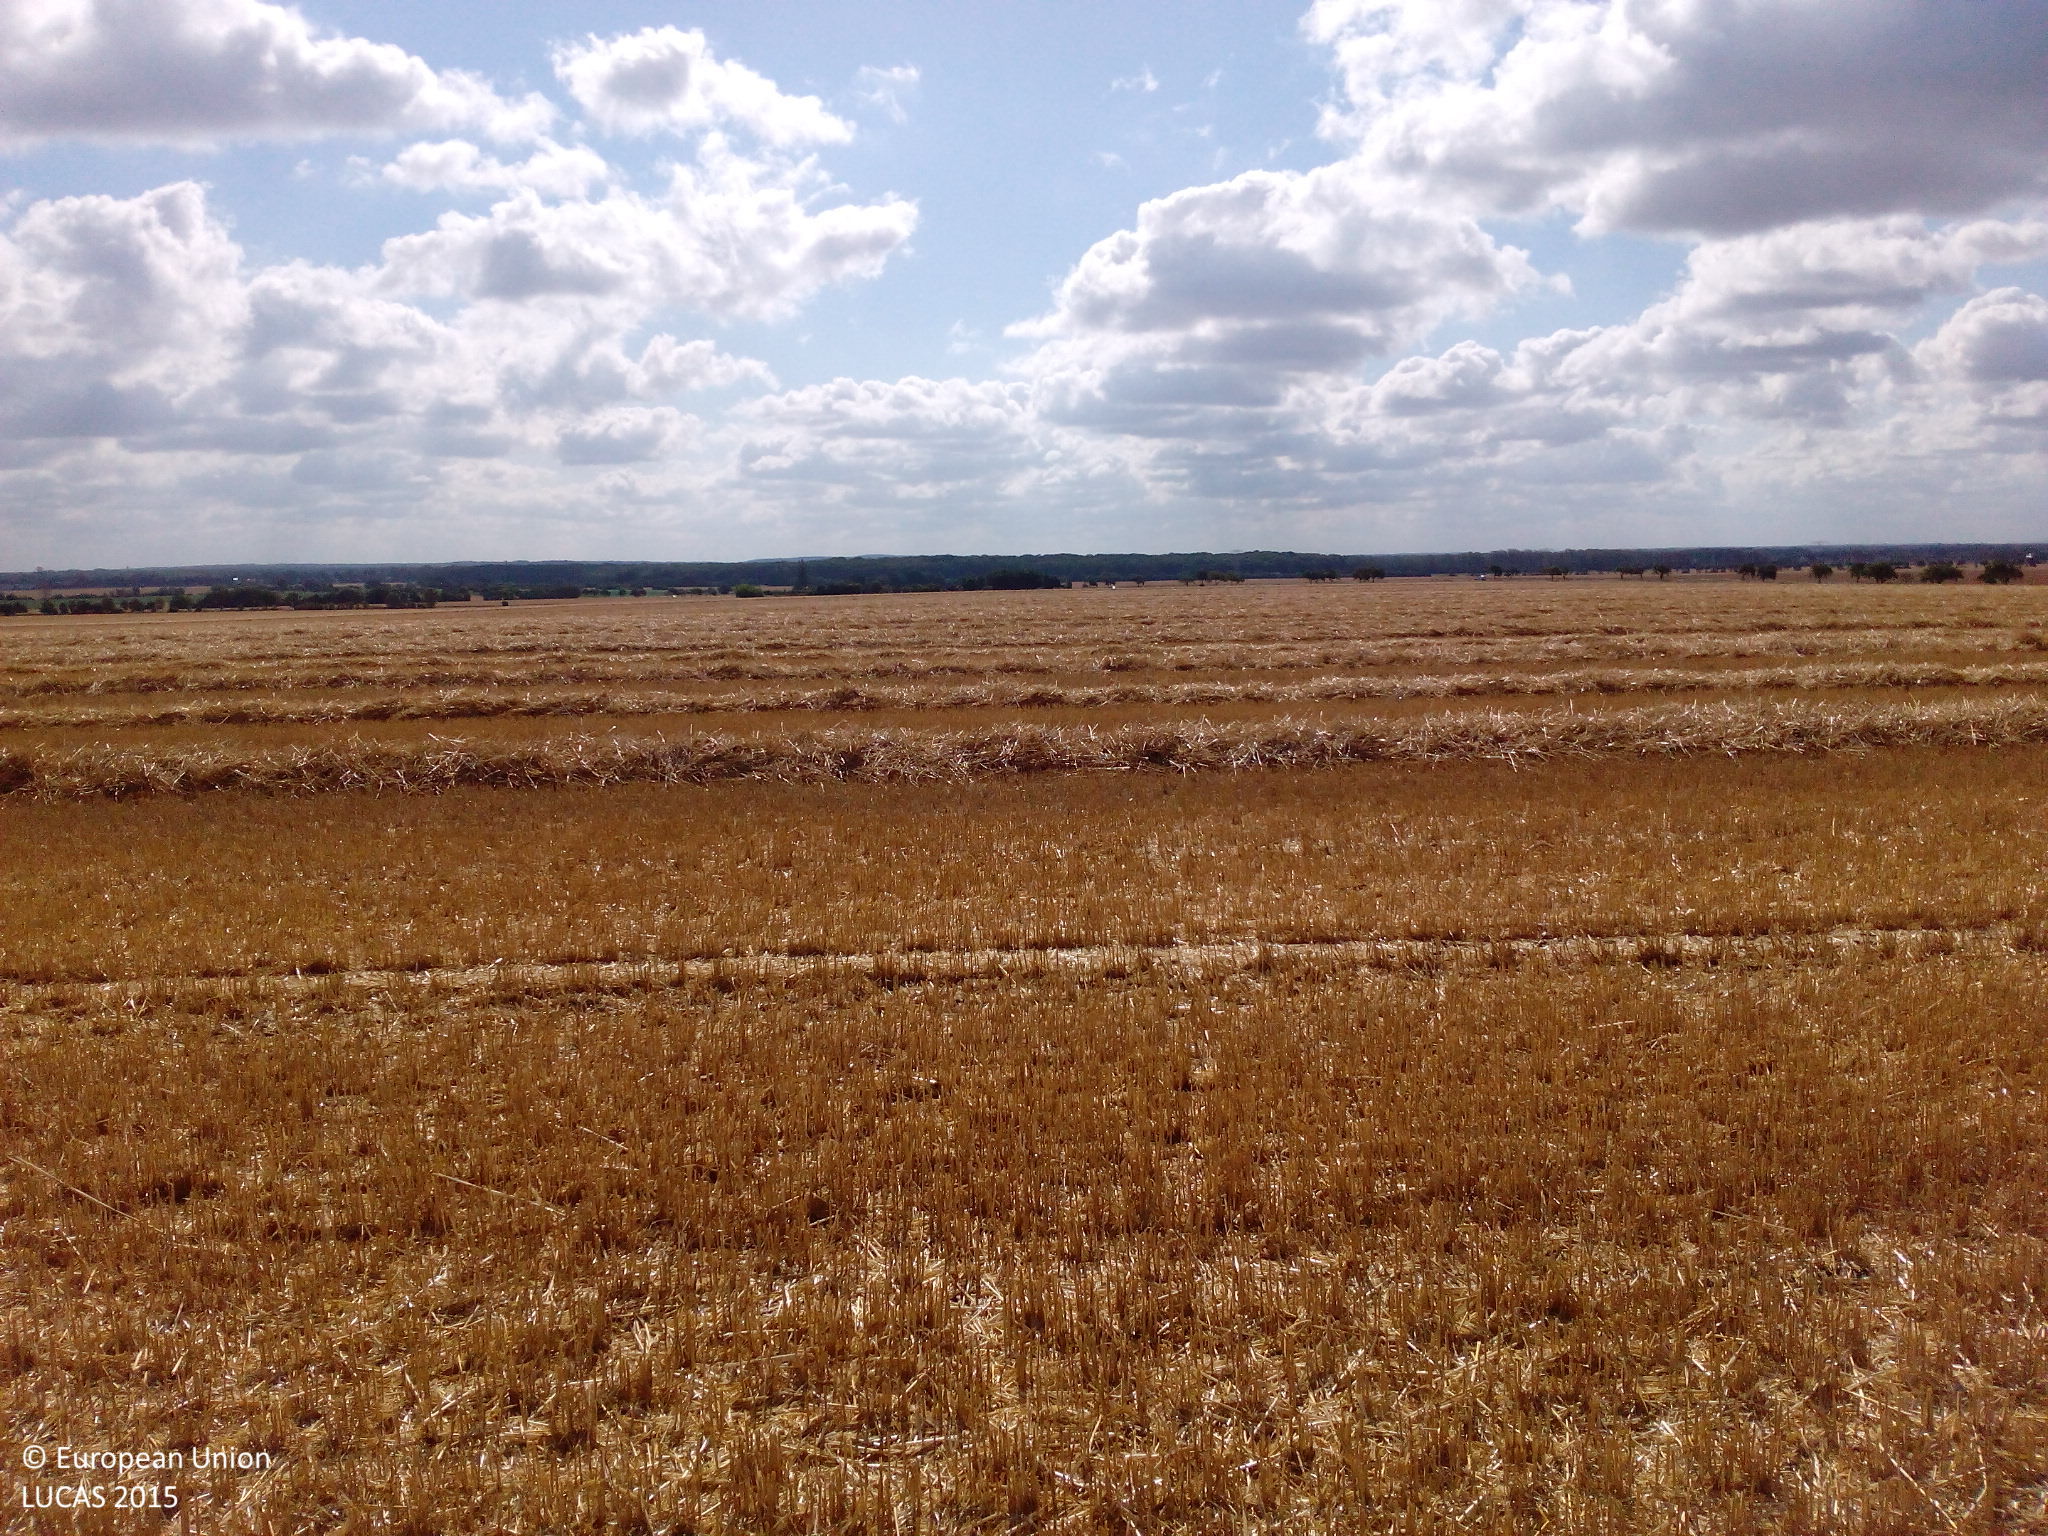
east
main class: Cropland
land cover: Durum wheat
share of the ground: 25 - 50 %
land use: Agriculture (excluding fallow land and kitchen gardens)
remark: Harvested field
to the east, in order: Durum wheat
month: July
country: DE
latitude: 51.2713
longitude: 12.5368
